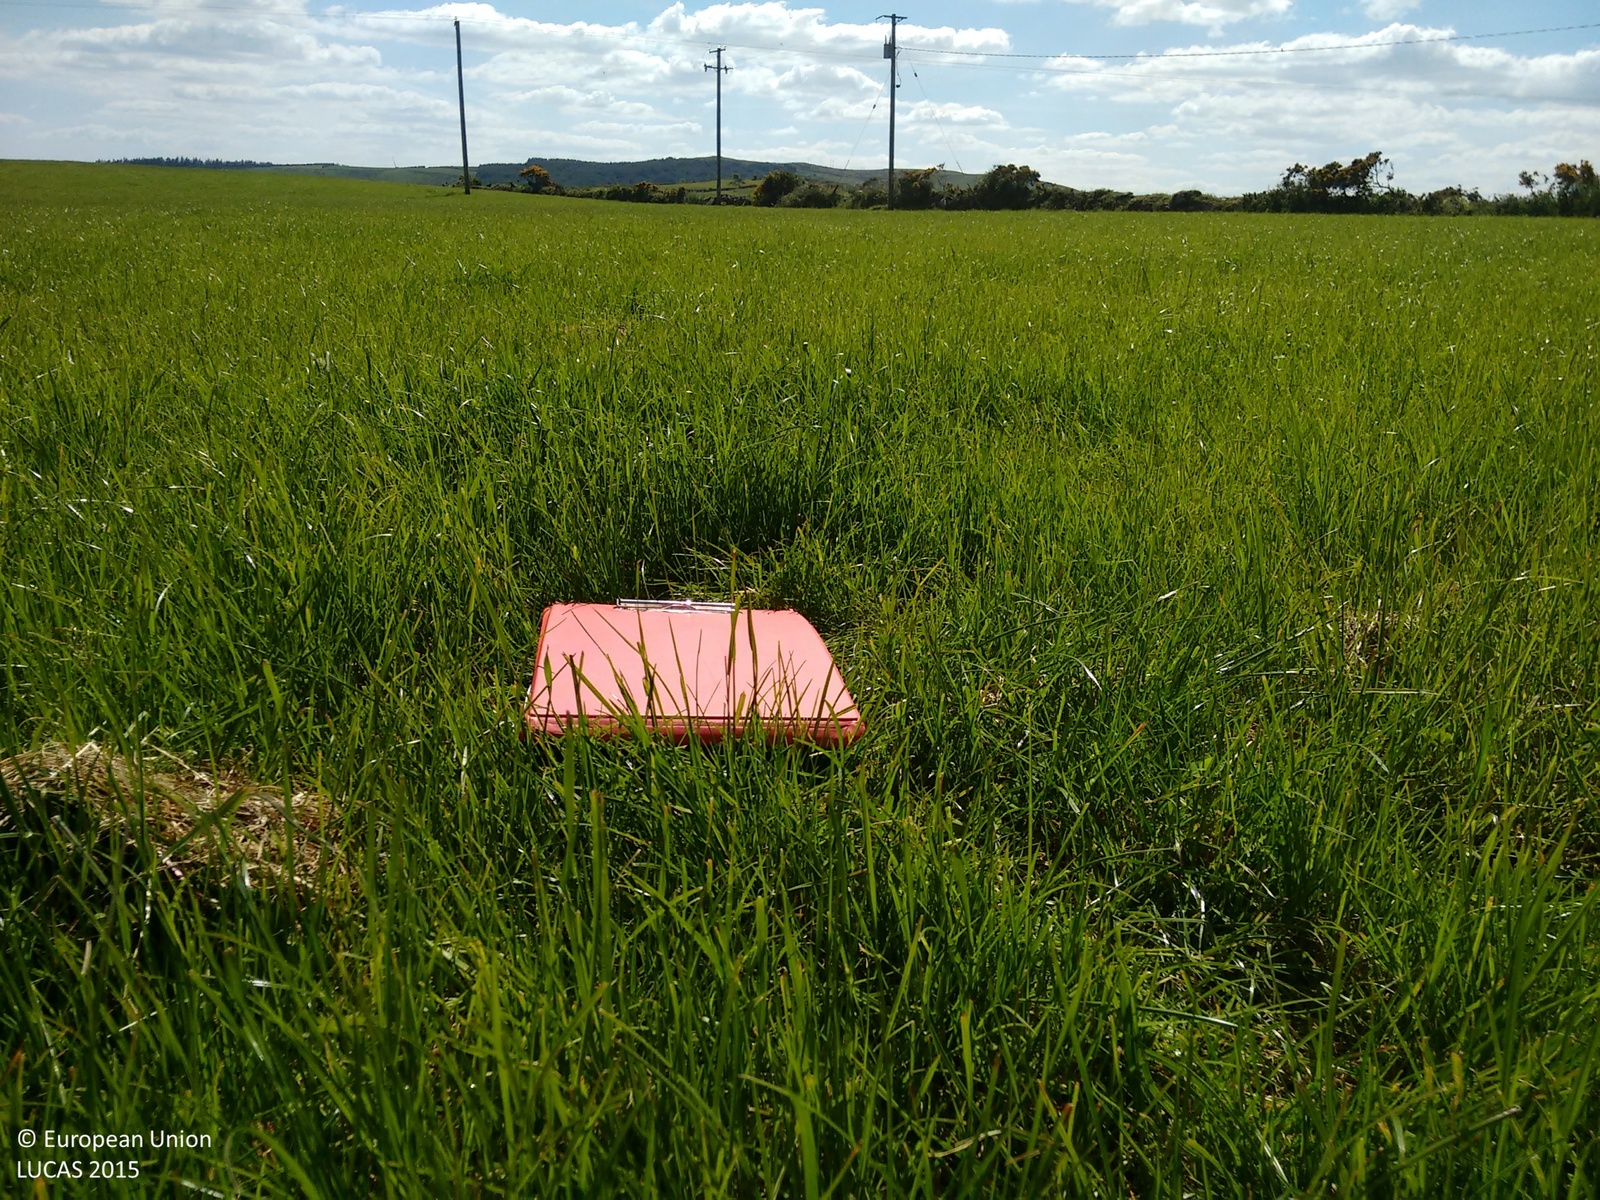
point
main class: Grassland
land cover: Grassland without tree/shrub cover
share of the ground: > 75 %
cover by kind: herbaceous plants 95 %, shrubs 5 %
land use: Agriculture (excluding fallow land and kitchen gardens)
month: June
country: IE
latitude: 51.9911
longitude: -8.8628
